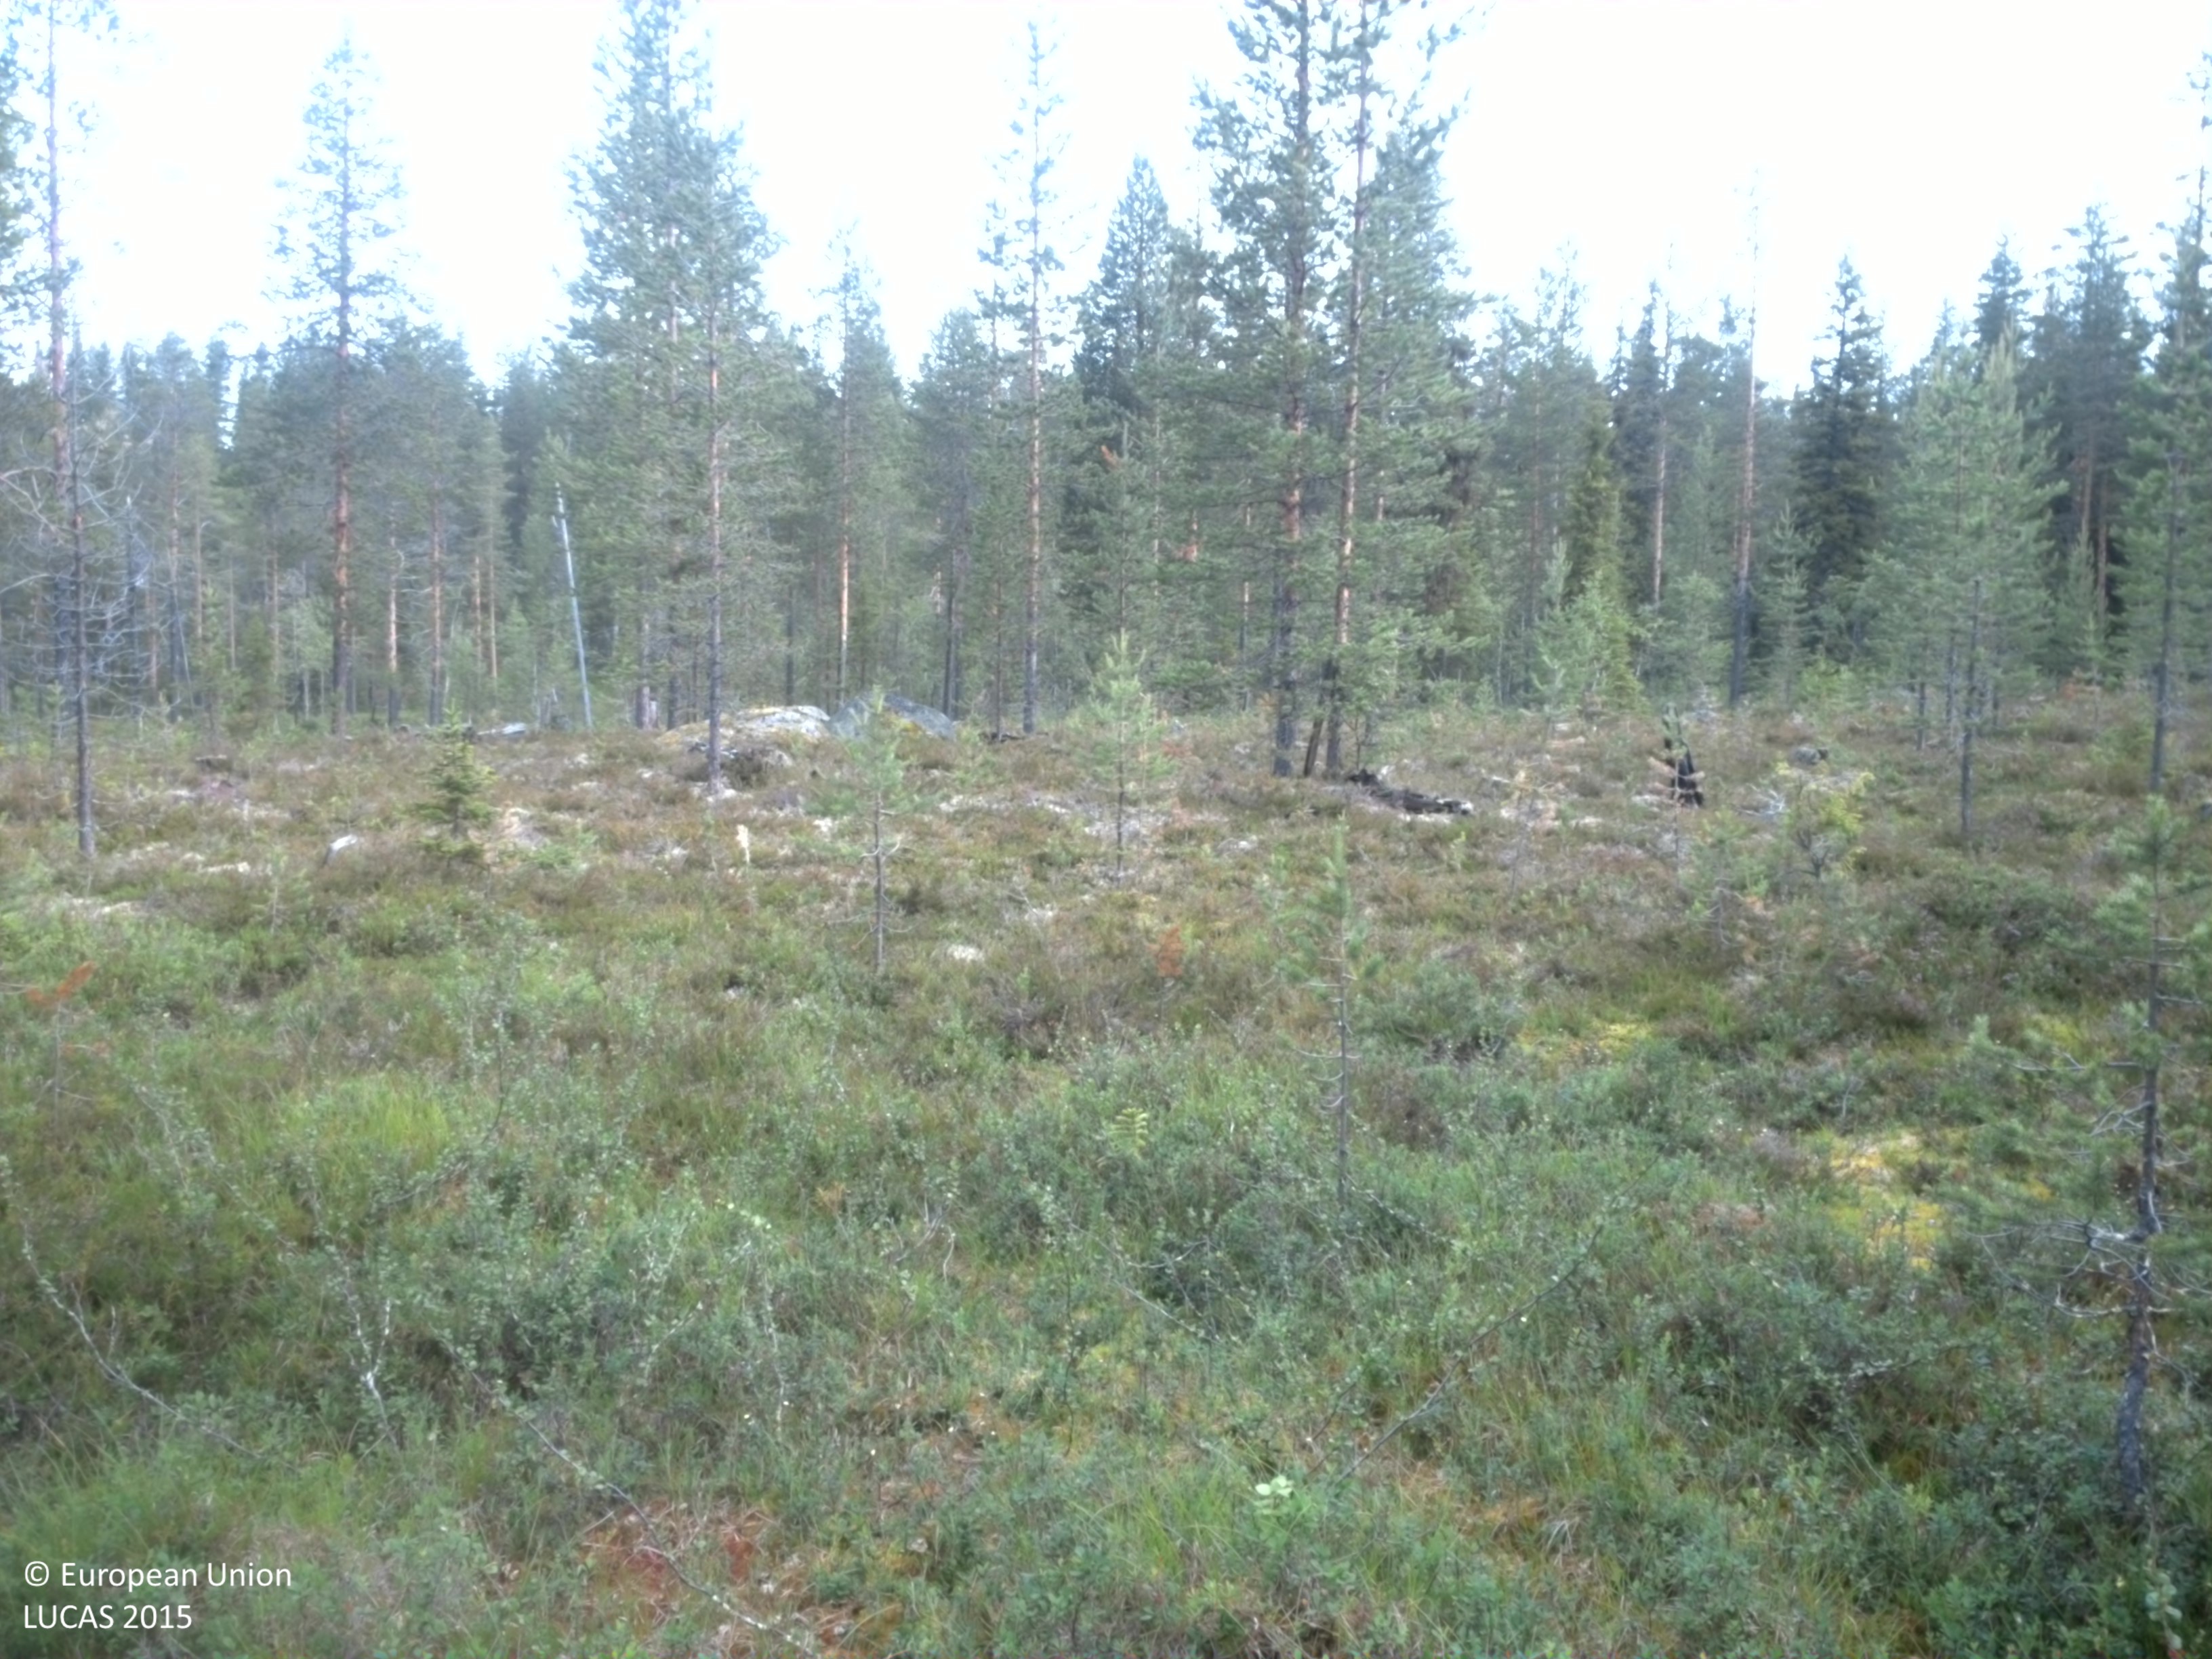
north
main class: Shrubland
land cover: Shrubland with sparse tree cover
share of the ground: > 75 %
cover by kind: shrubs 90 %, coniferous forest trees 5 %, lichens and mosses 5 %
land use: Forestry
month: August
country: SE
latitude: 66.0854
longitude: 19.7510
